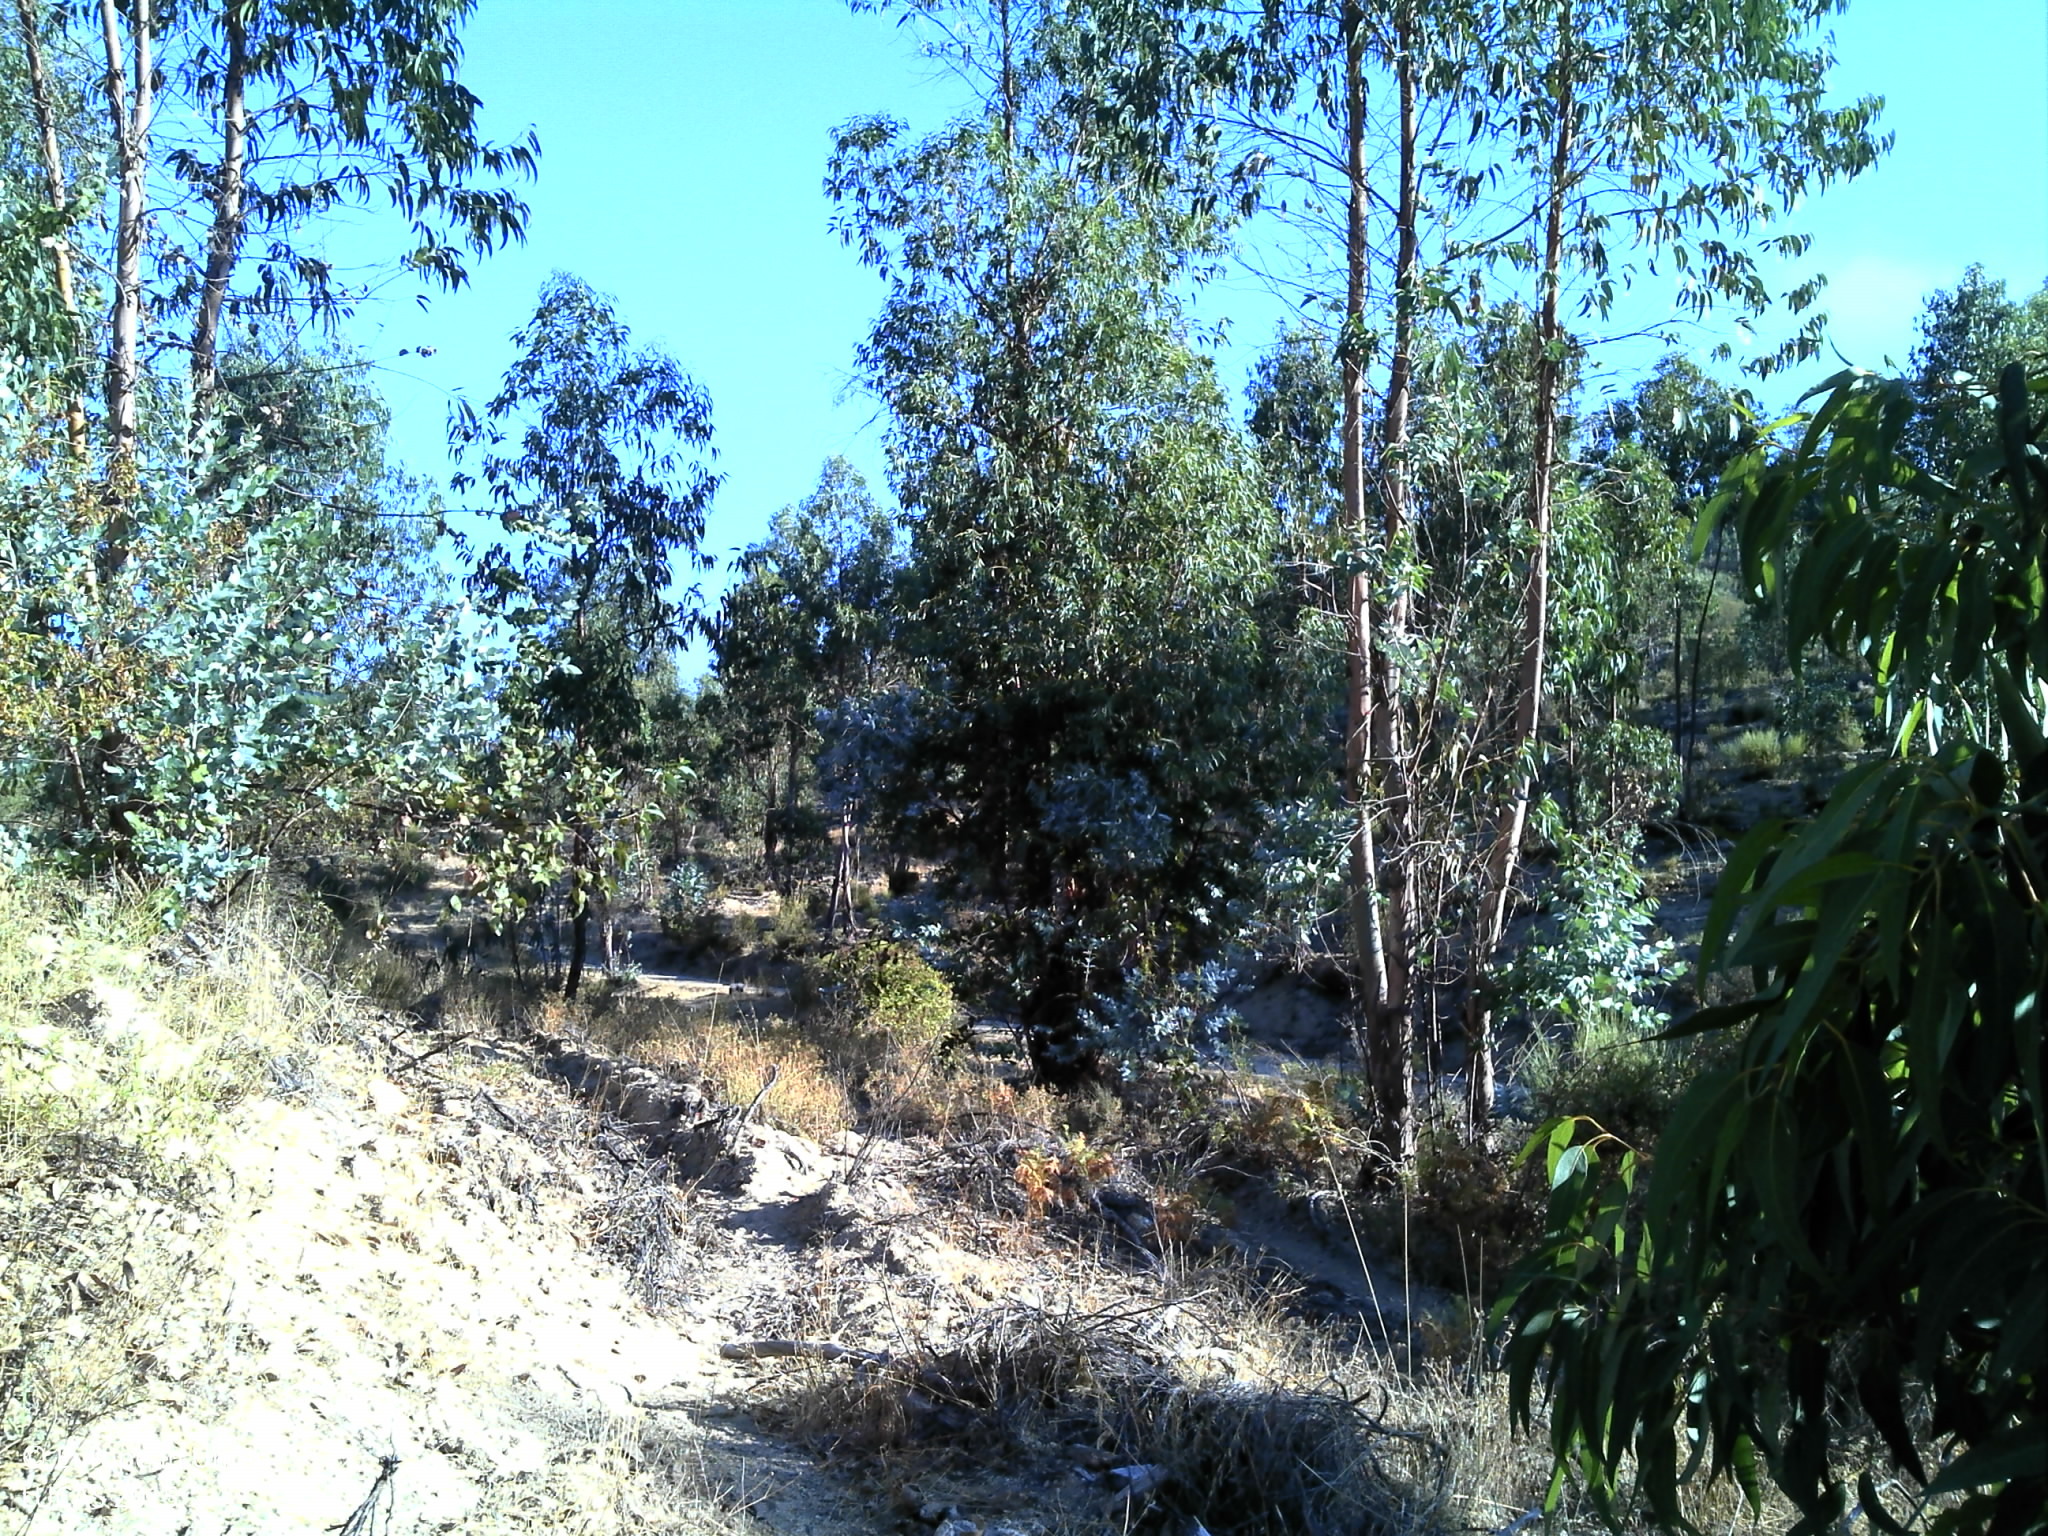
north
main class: Woodland
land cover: Broadleaved woodland
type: broadleaved evergreen forest
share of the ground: 10 - 25 %
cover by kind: unconsolidated bare surface 75 %, broadleaved forest trees 10 %, herbaceous plants 10 %, shrubs 5 %
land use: Forestry
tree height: > 5 m
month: August
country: PT
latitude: 39.5173
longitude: -7.7690
